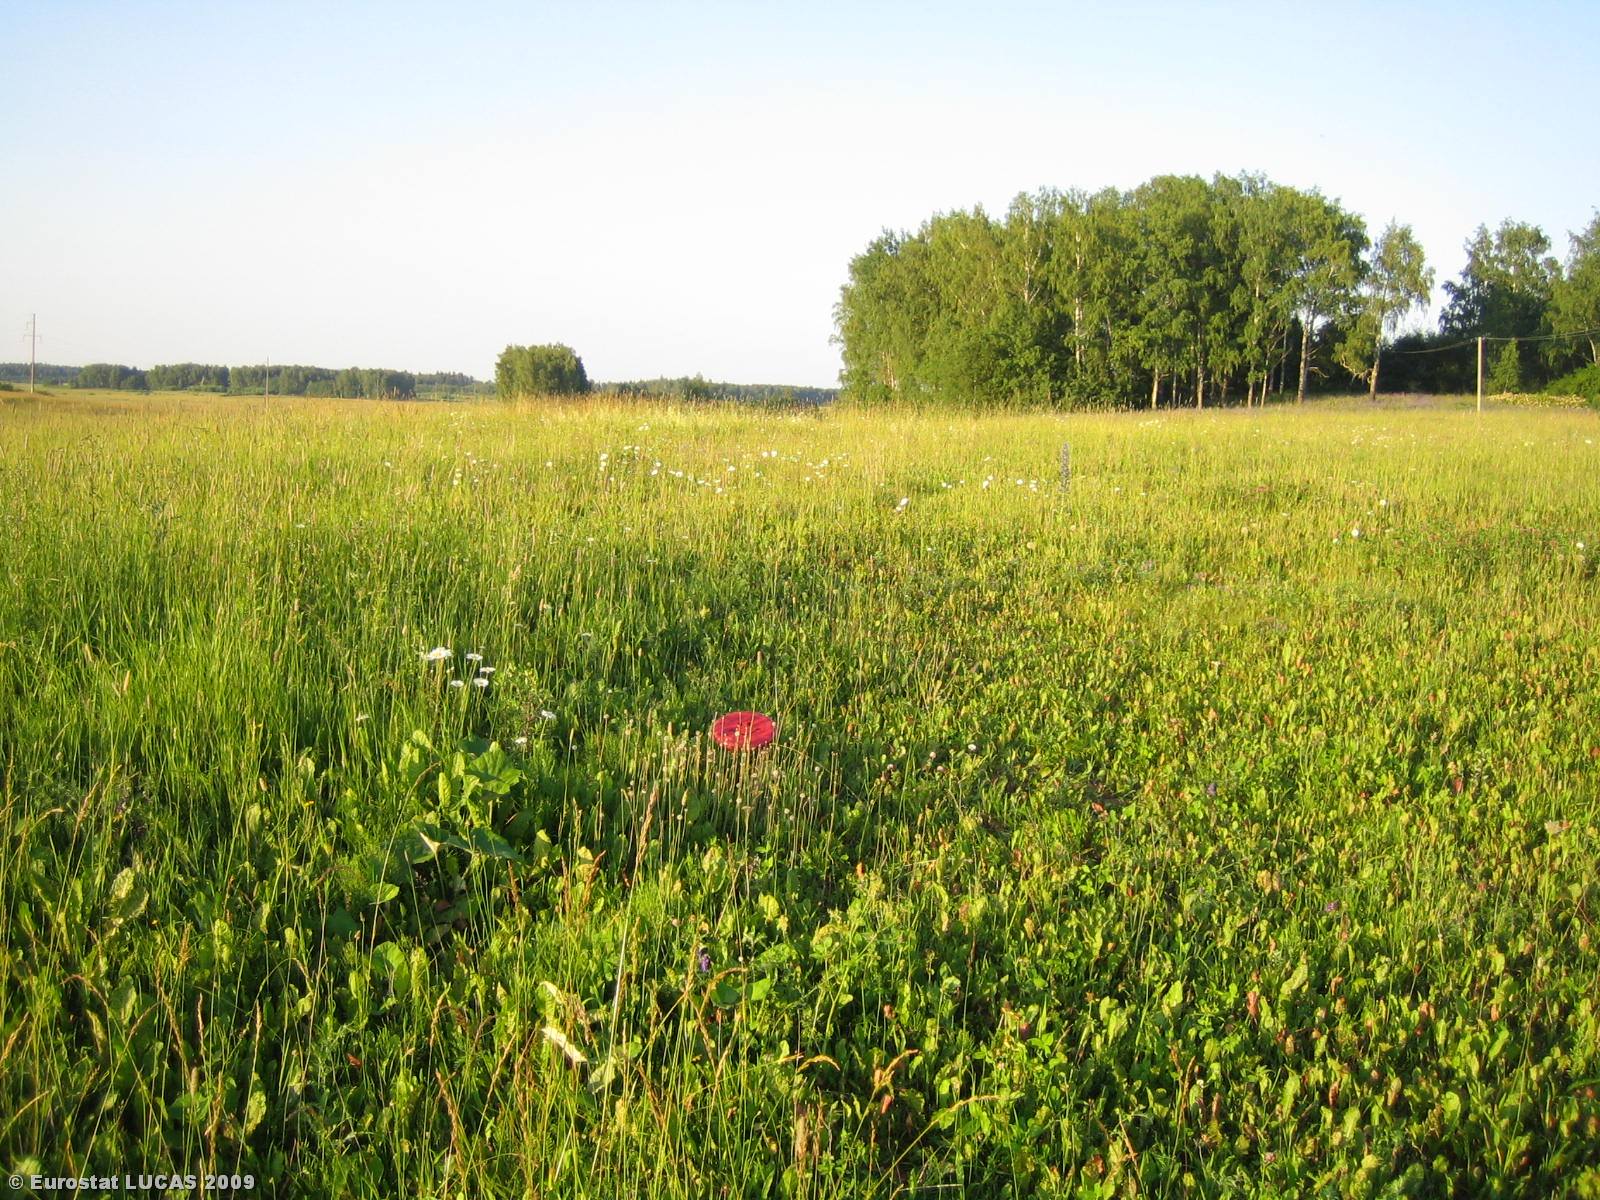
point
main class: Cropland
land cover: Clovers
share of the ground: > 75 %
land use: Agriculture (excluding fallow land and kitchen gardens)
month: July
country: LT
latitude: 55.6135
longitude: 25.8673
